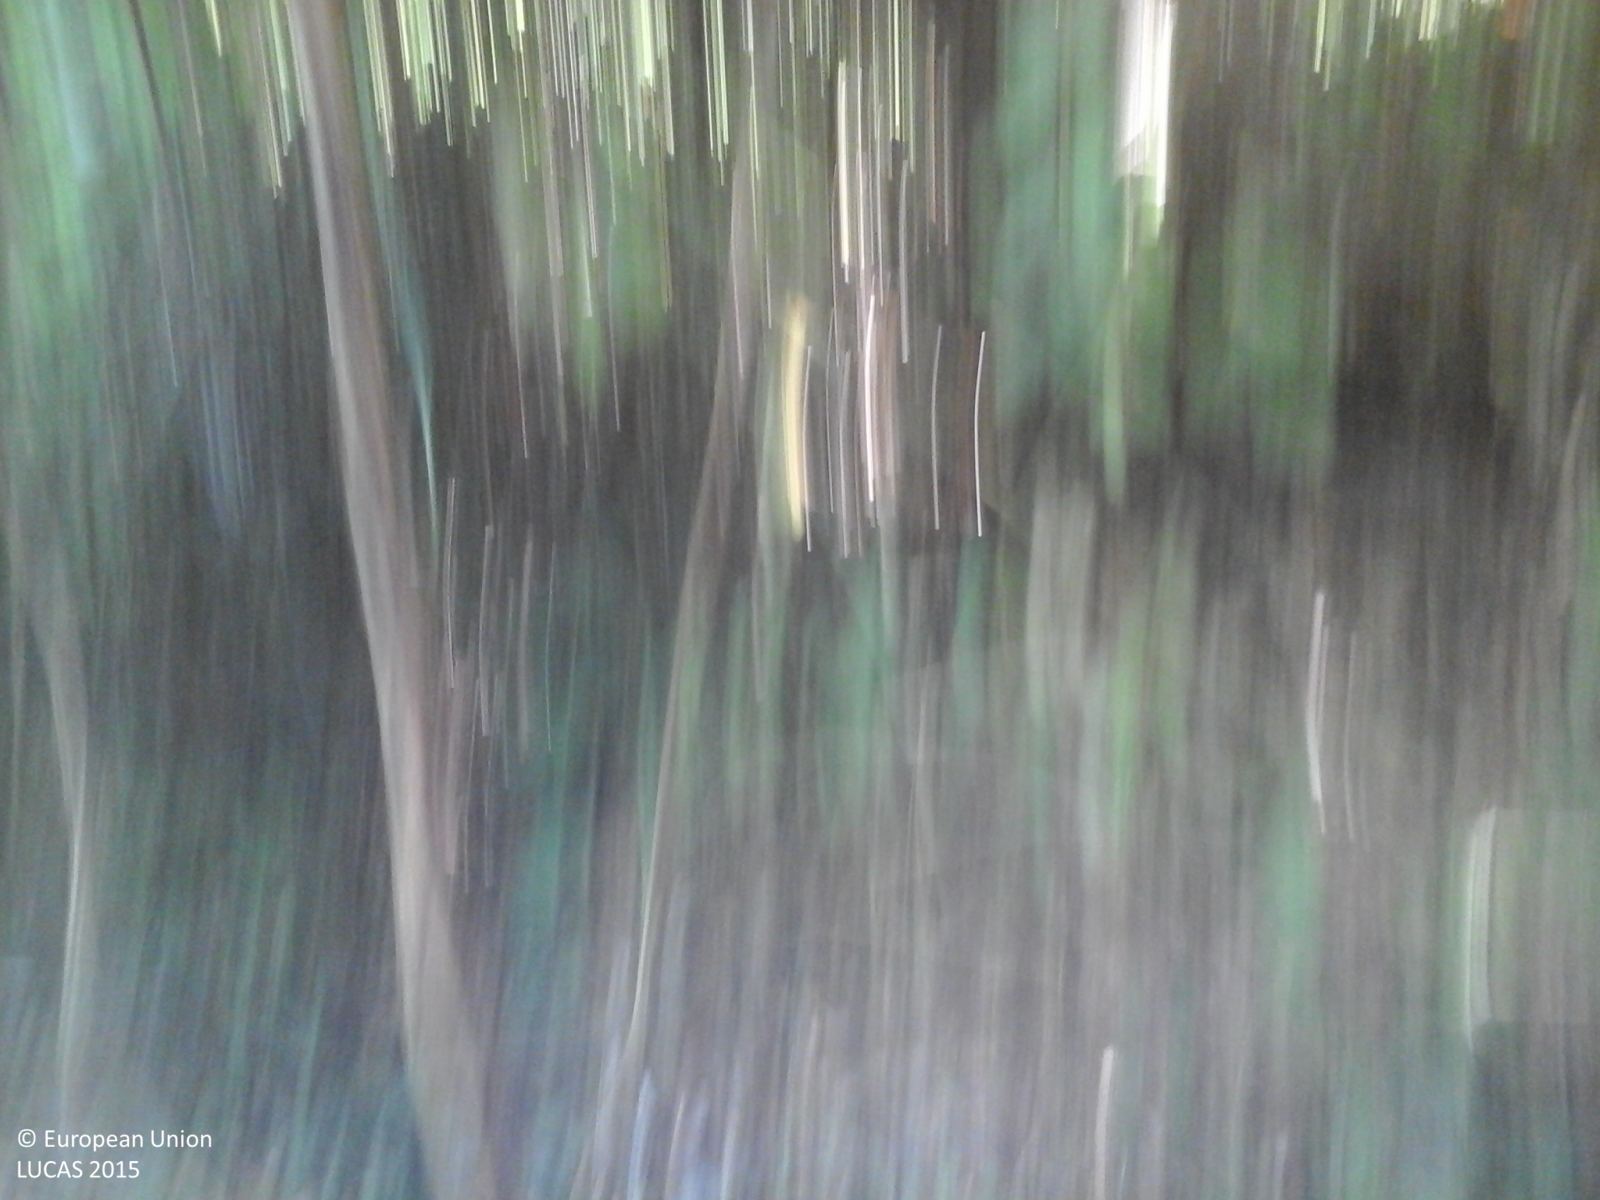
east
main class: Woodland
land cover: Broadleaved woodland
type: thermophilous deciduous forest
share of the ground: > 75 %
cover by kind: broadleaved forest trees 100 %
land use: Semi-natural and natural areas not in use
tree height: > 5 m
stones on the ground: < 10 %
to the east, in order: Broadleaved woodland; Shrubland with sparse tree cover; Broadleaved woodland; Tracks; Broadleaved woodland; Olive groves; Broadleaved woodland; Tracks; Grass margins; Common wheat
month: August
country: IT
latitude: 43.1359
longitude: 13.4945
